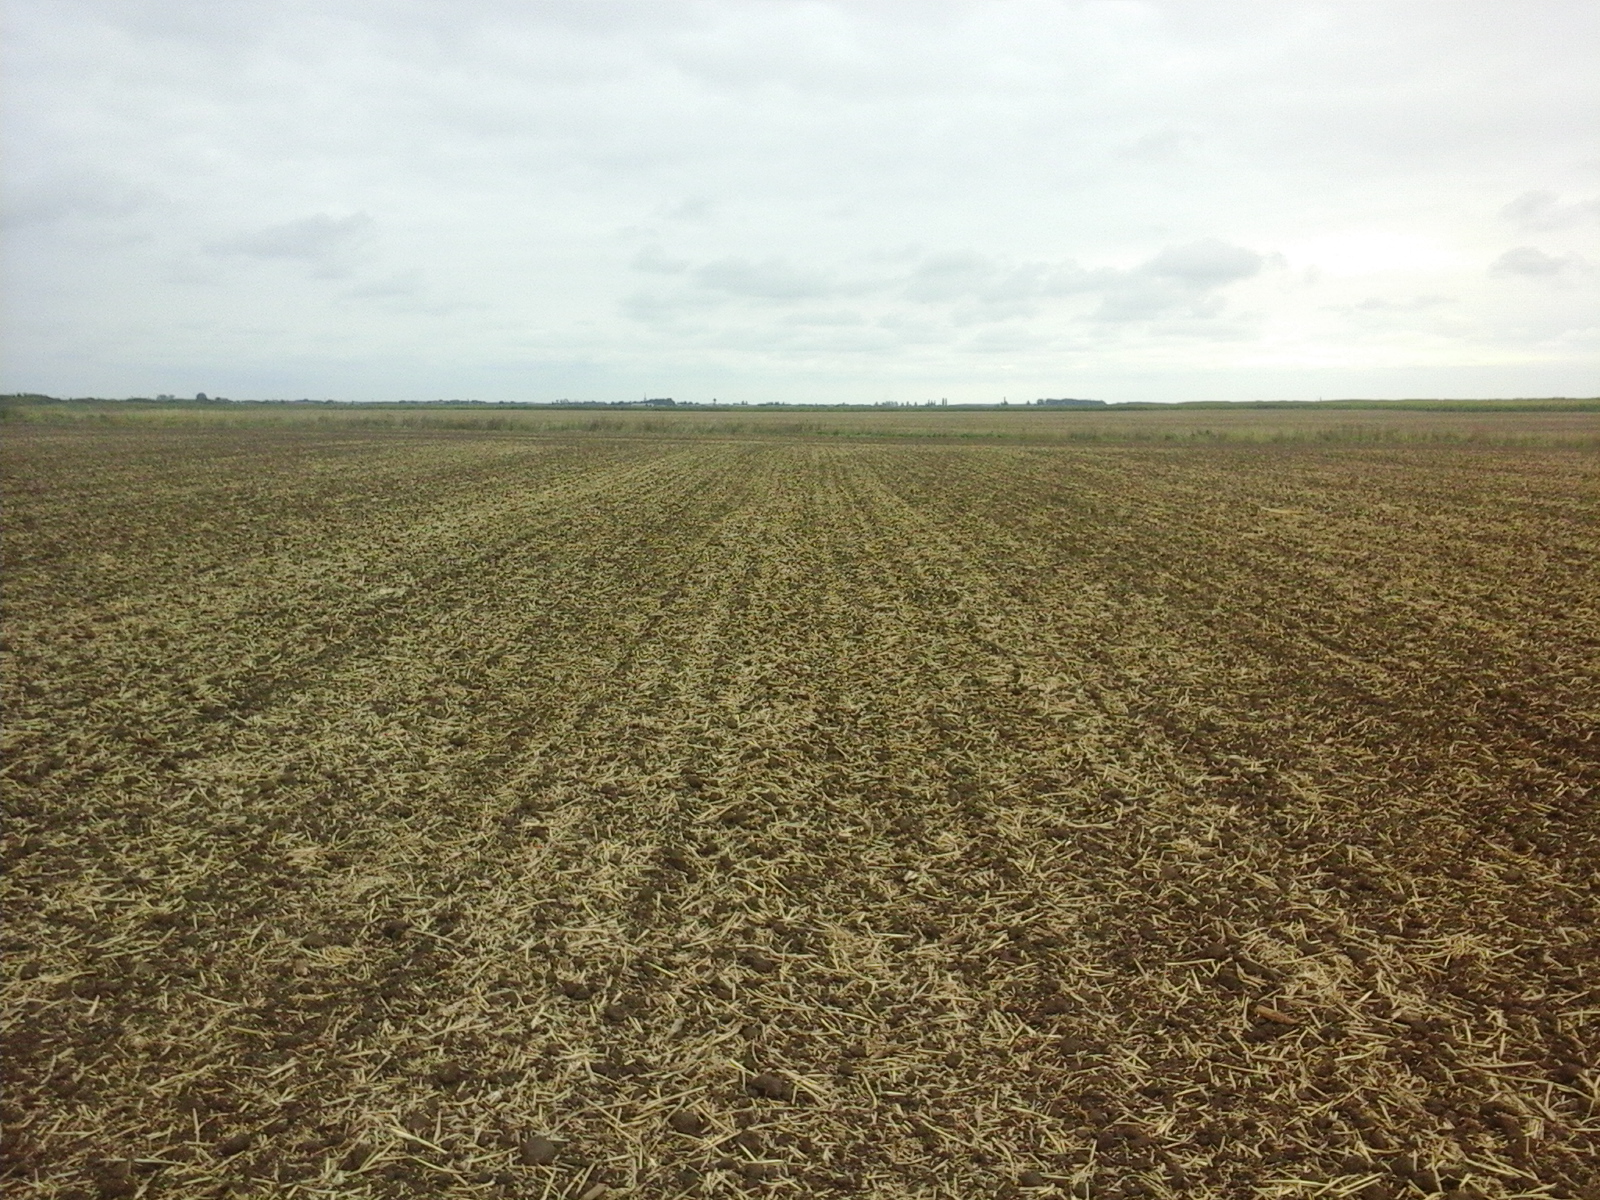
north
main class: Cropland
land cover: Common wheat
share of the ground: < 10 %
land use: Agriculture (excluding fallow land and kitchen gardens)
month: September
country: RO
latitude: 47.1901
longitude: 21.9385
